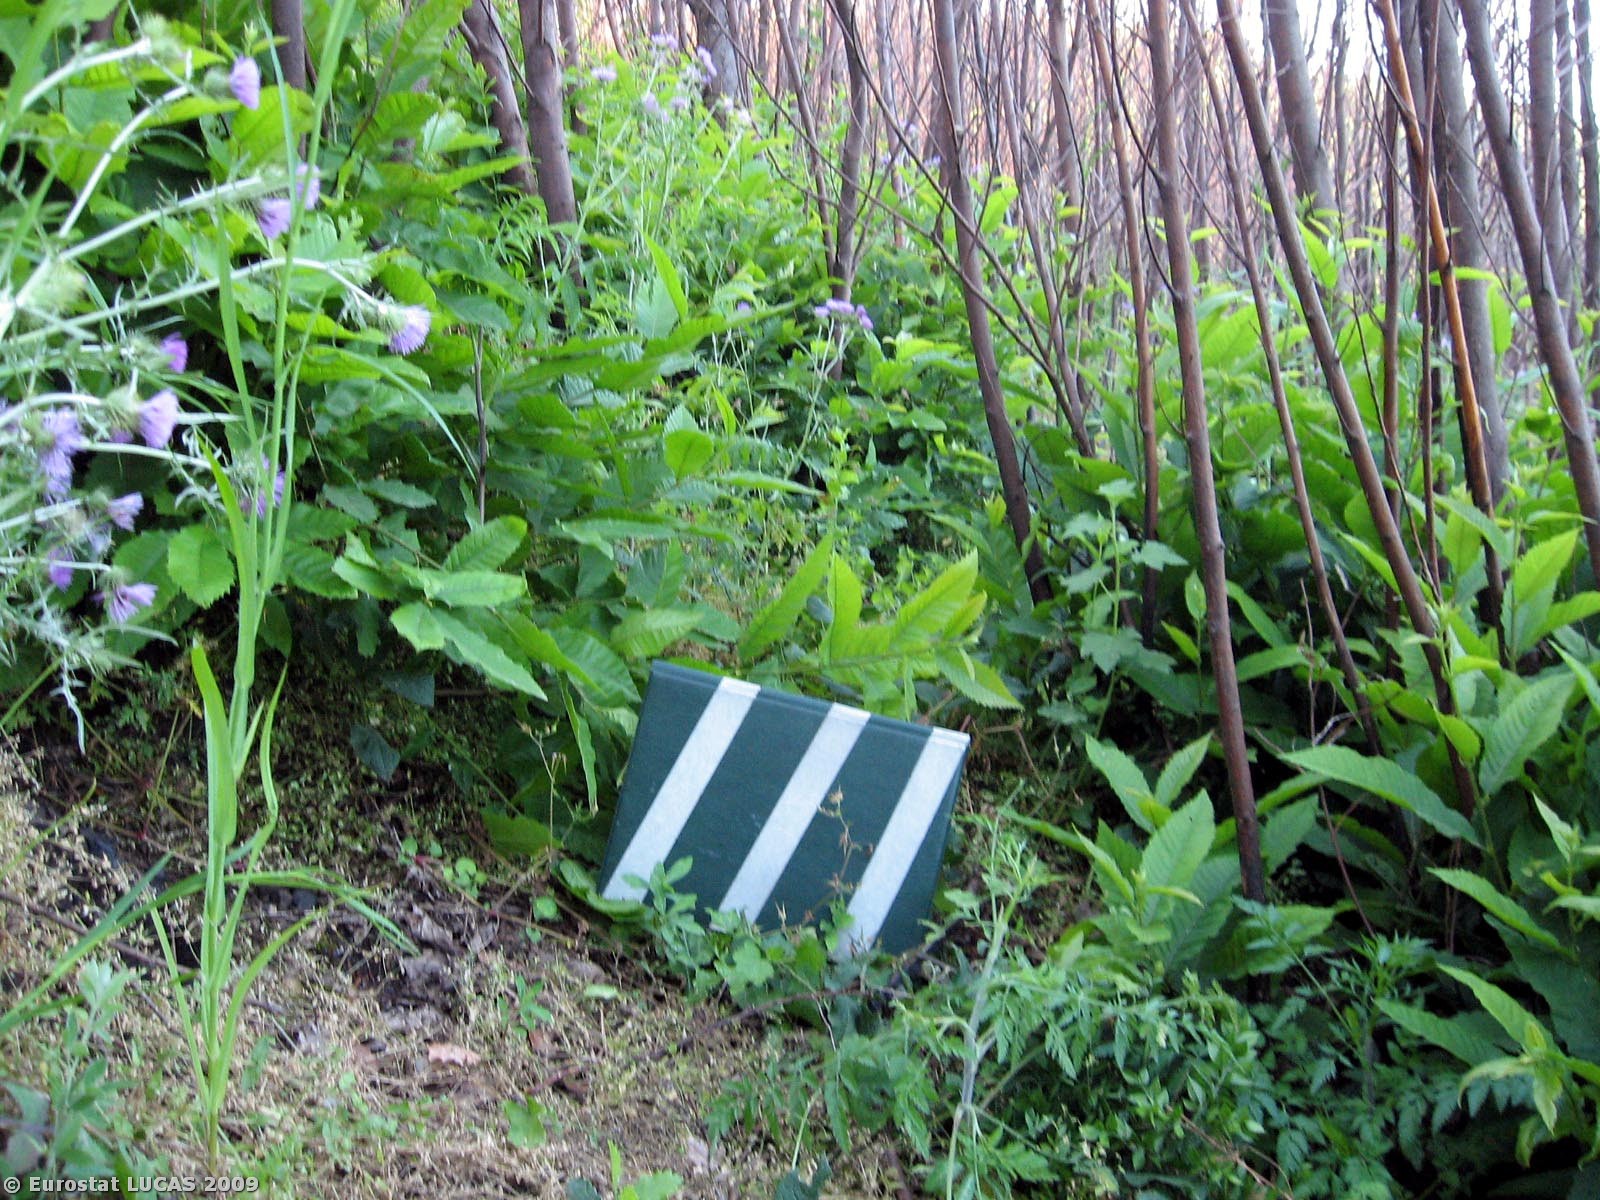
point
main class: Woodland
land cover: Broadleaved woodland
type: thermophilous deciduous forest
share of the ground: 25 - 50 %
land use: Forestry
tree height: > 5 m
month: June
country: IT
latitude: 38.8228
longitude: 16.4045
